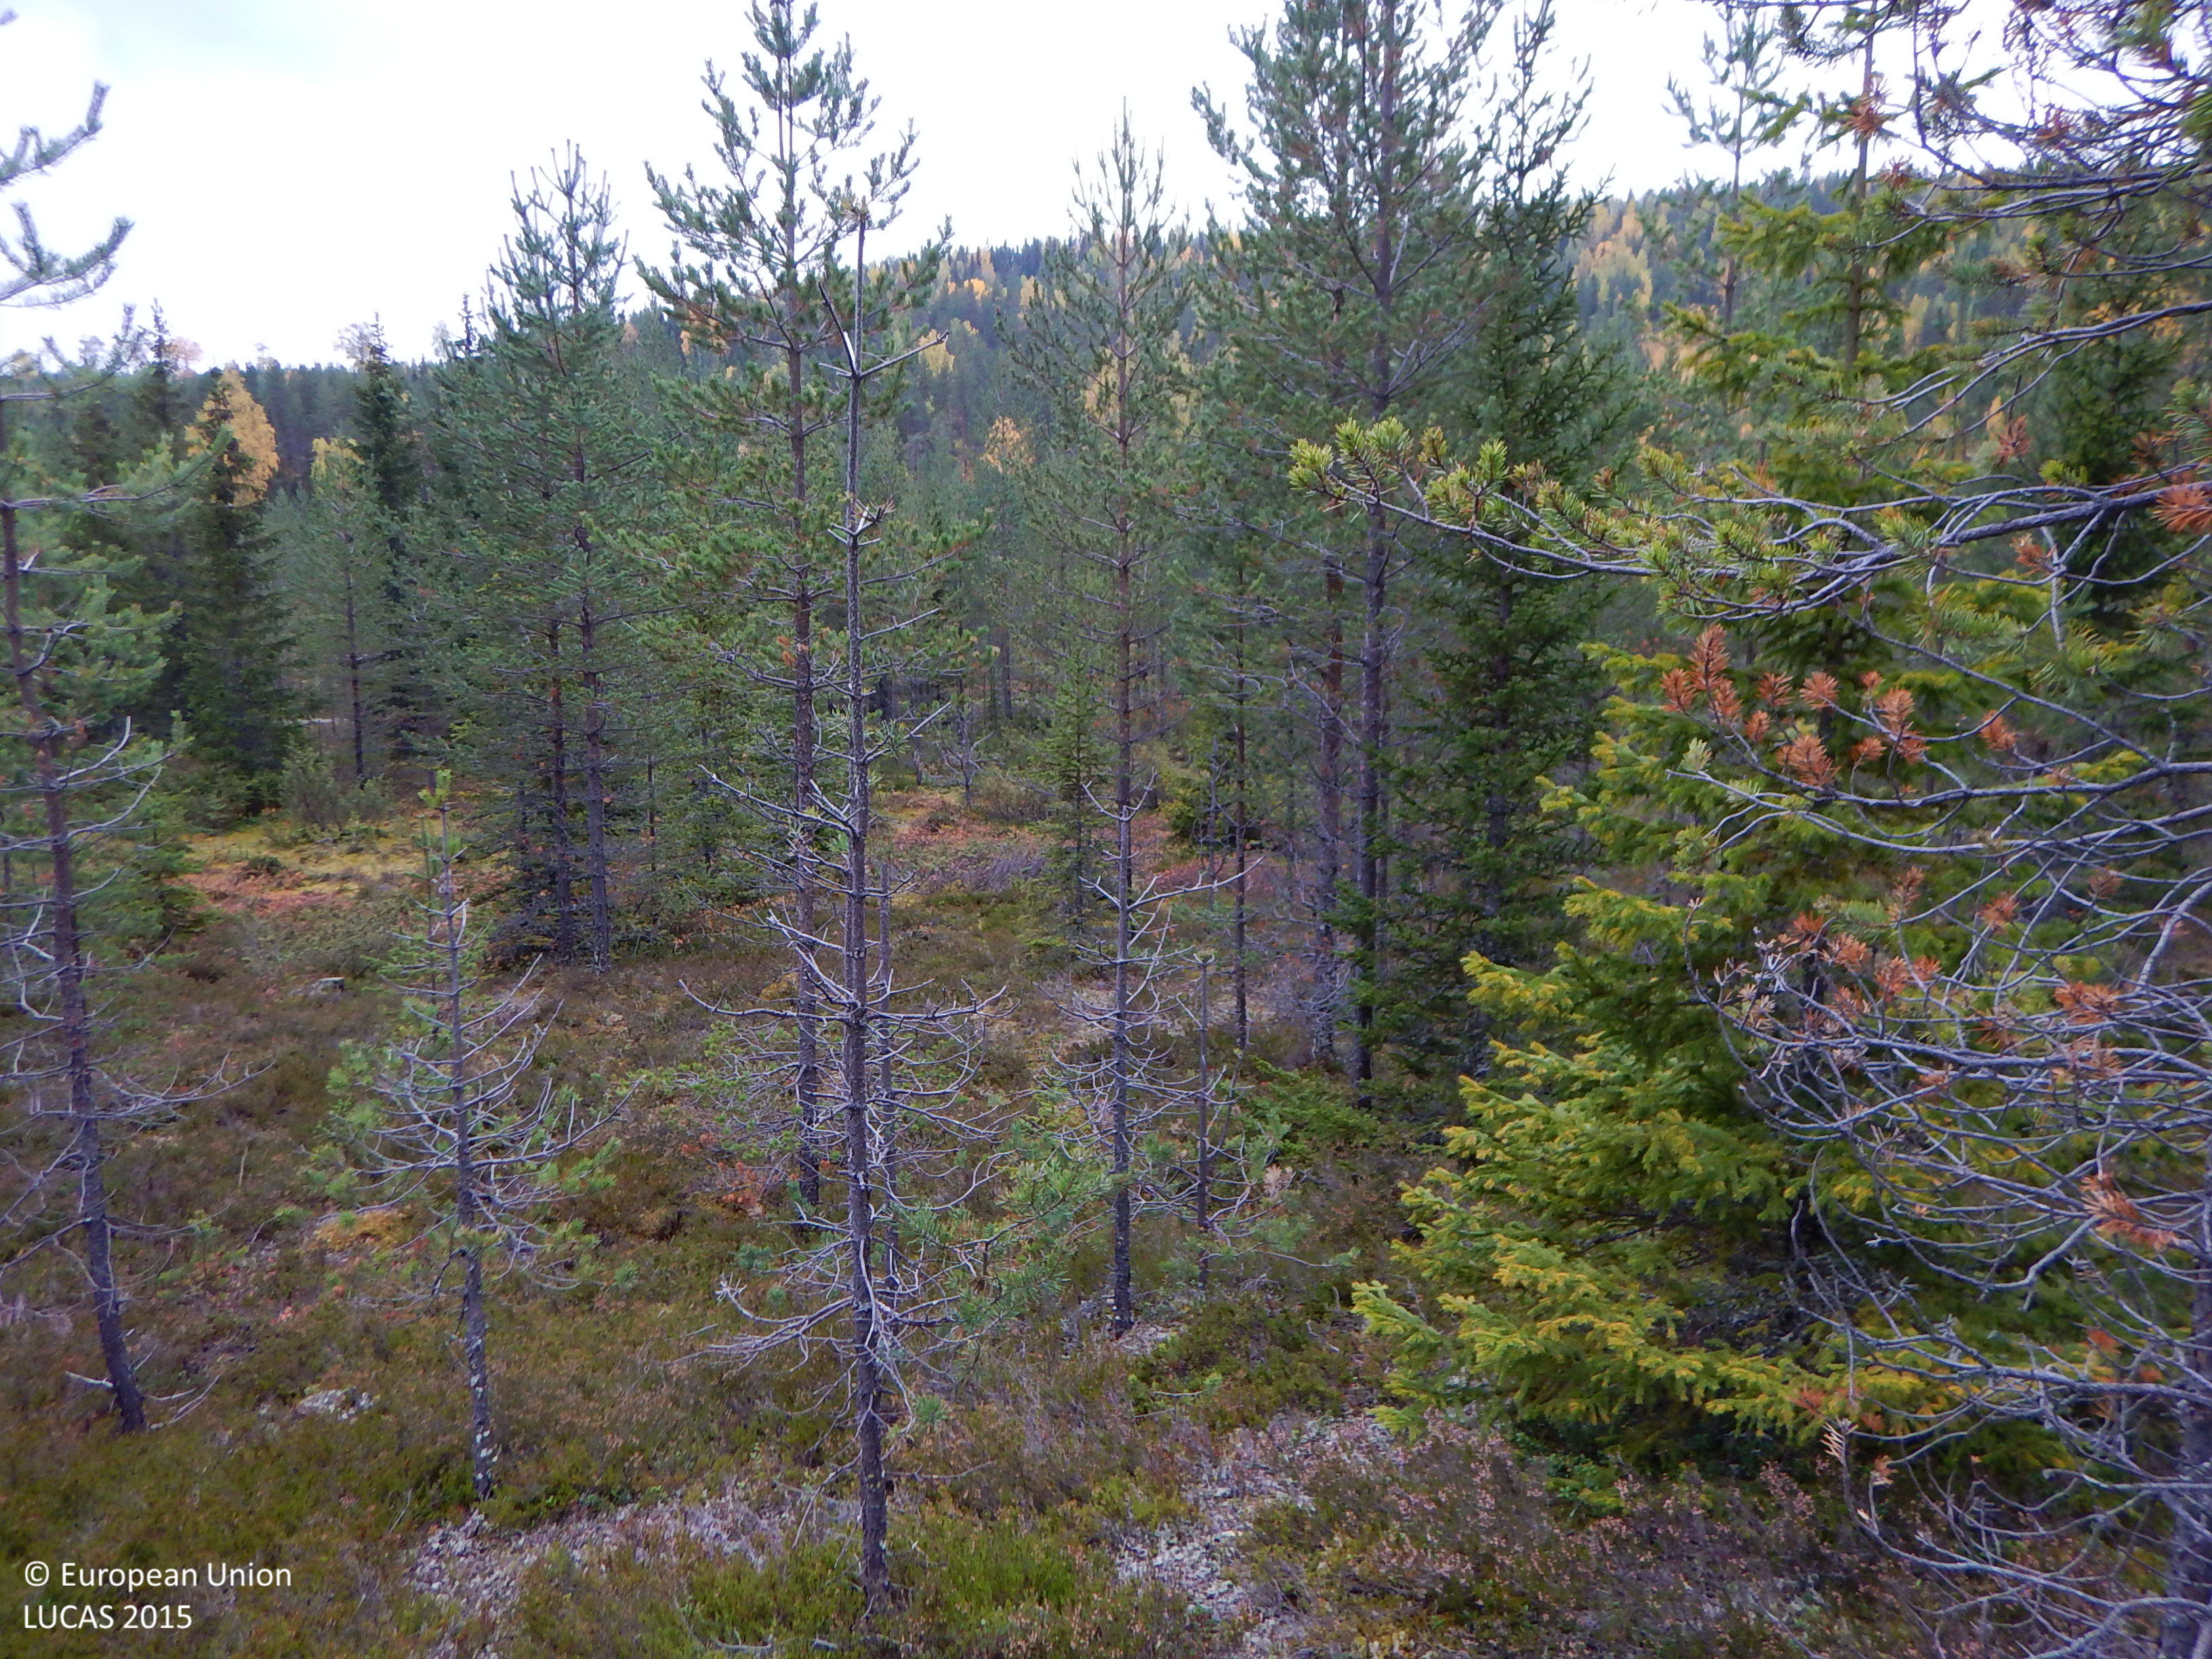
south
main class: Woodland
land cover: Pine dominated coniferous woodland
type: boreal forest
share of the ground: 50 - 75 %
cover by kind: coniferous forest trees 60 %, shrubs 15 %, lichens and mosses 15 %, herbaceous plants 5 %, unconsolidated bare surface 5 %
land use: Forestry
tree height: > 5 m
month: September
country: SE
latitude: 65.0790
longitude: 19.1749
